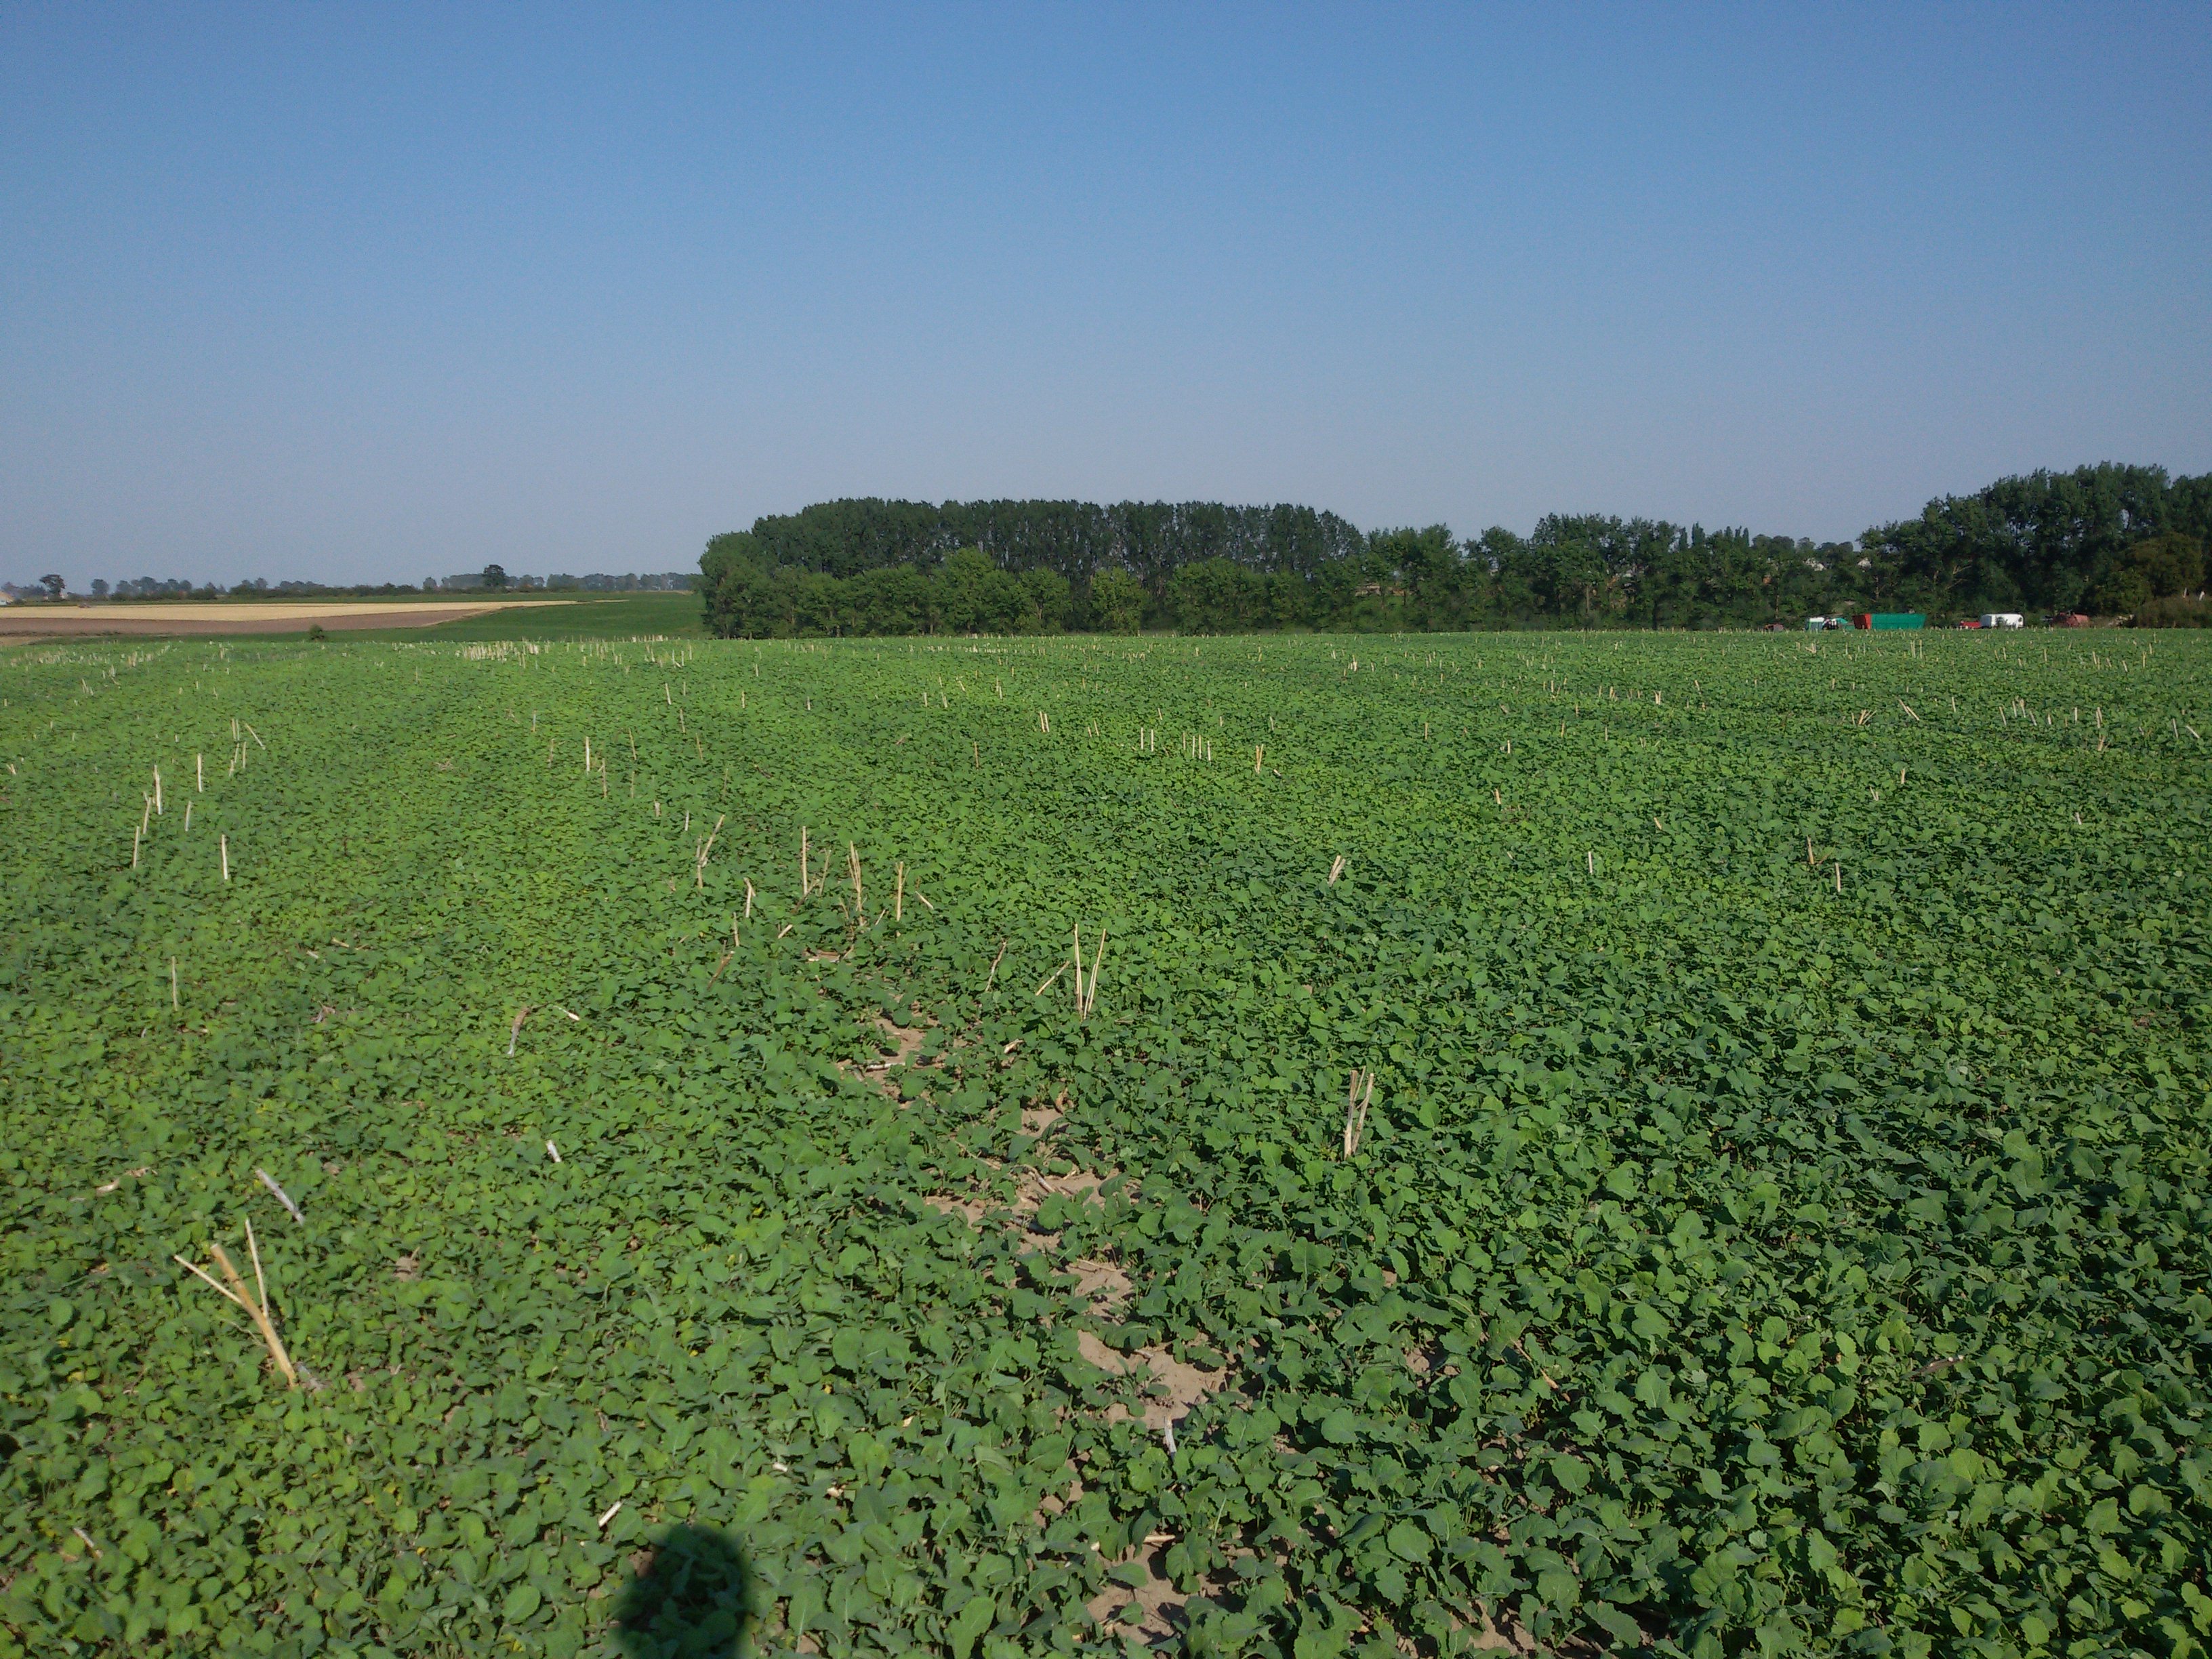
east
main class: Cropland
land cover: Rape and turnip rape
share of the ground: > 75 %
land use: Agriculture (excluding fallow land and kitchen gardens)
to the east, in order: Rape and turnip rape
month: August
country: PL
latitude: 52.5683
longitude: 17.5815
